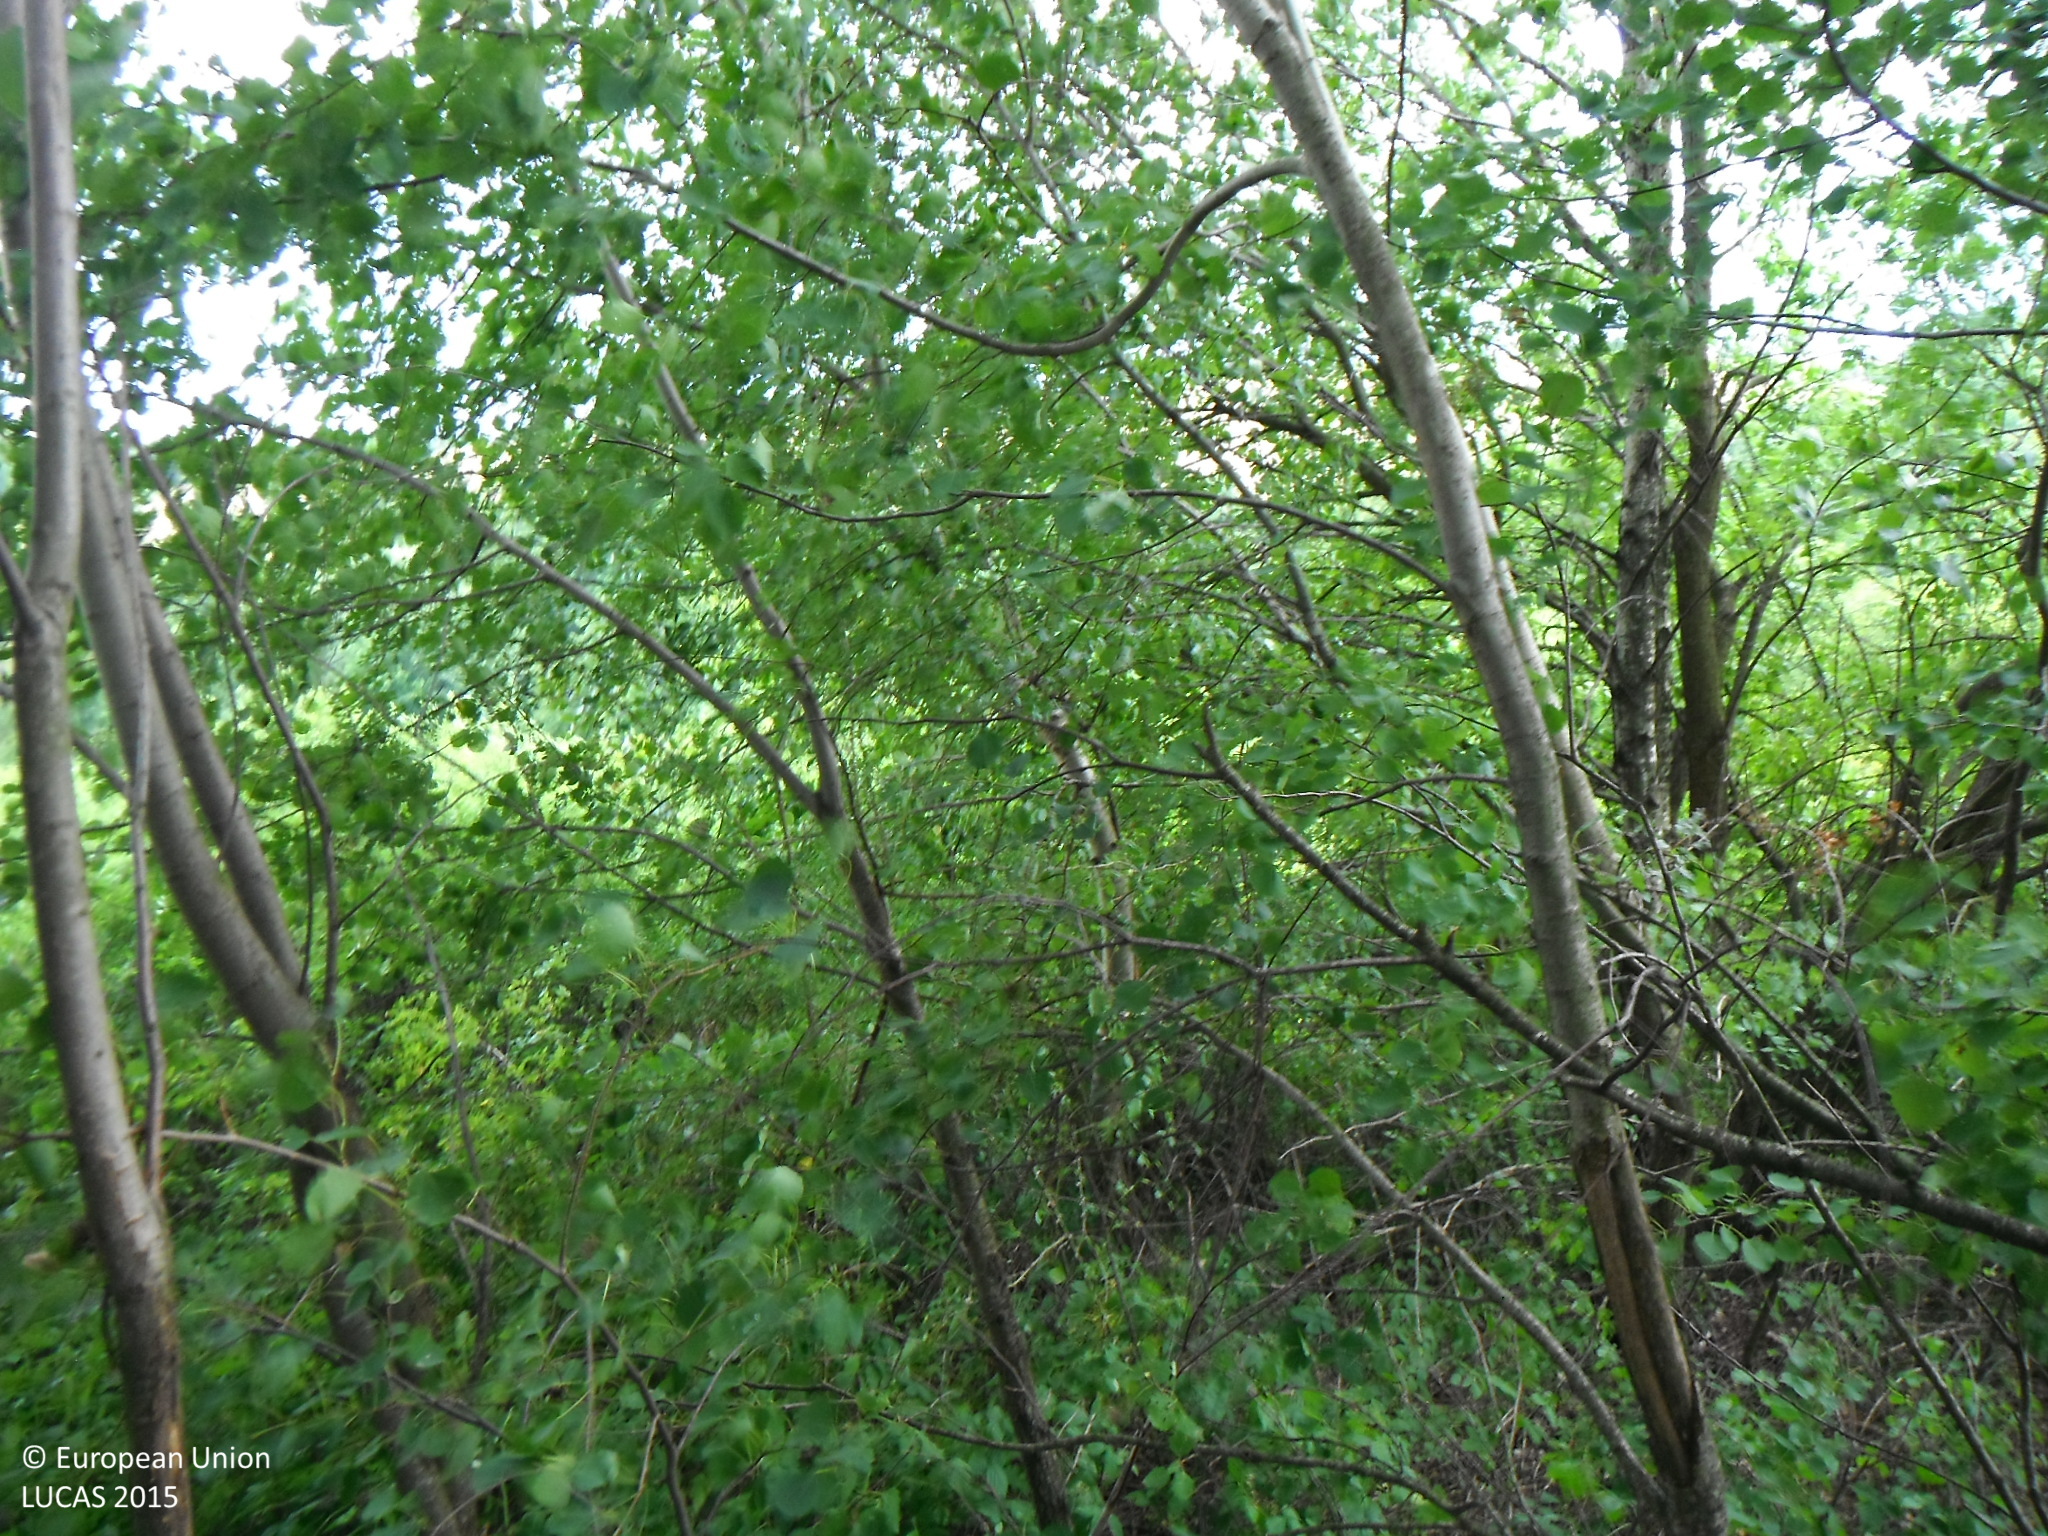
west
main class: Woodland
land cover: Broadleaved woodland
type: beech forest
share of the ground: > 75 %
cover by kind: broadleaved forest trees 100 %
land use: Forestry
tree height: > 5 m
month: July
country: SK
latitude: 49.3273
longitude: 21.6783
